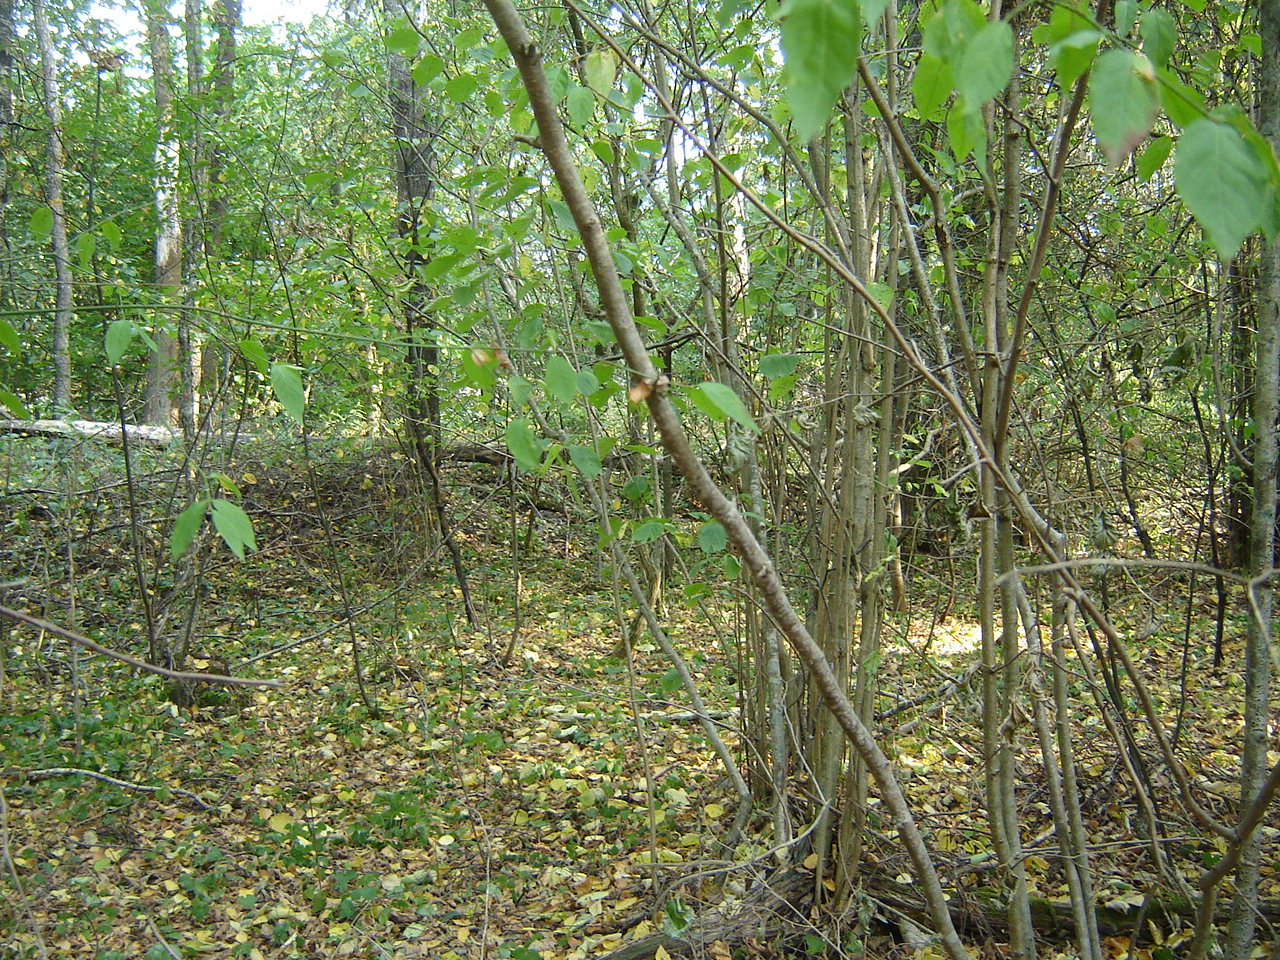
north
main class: Woodland
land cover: Spruce dominated mixed woodland
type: hemiboreal forest and nemoral coniferous forest and mixed broadleaved-coniferous forest
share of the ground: > 75 %
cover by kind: broadleaved forest trees 55 %, coniferous forest trees 30 %, unconsolidated bare surface 10 %, herbaceous plants 5 %
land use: Forestry
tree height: > 5 m
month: September
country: LT
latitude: 54.5037
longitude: 25.2075
